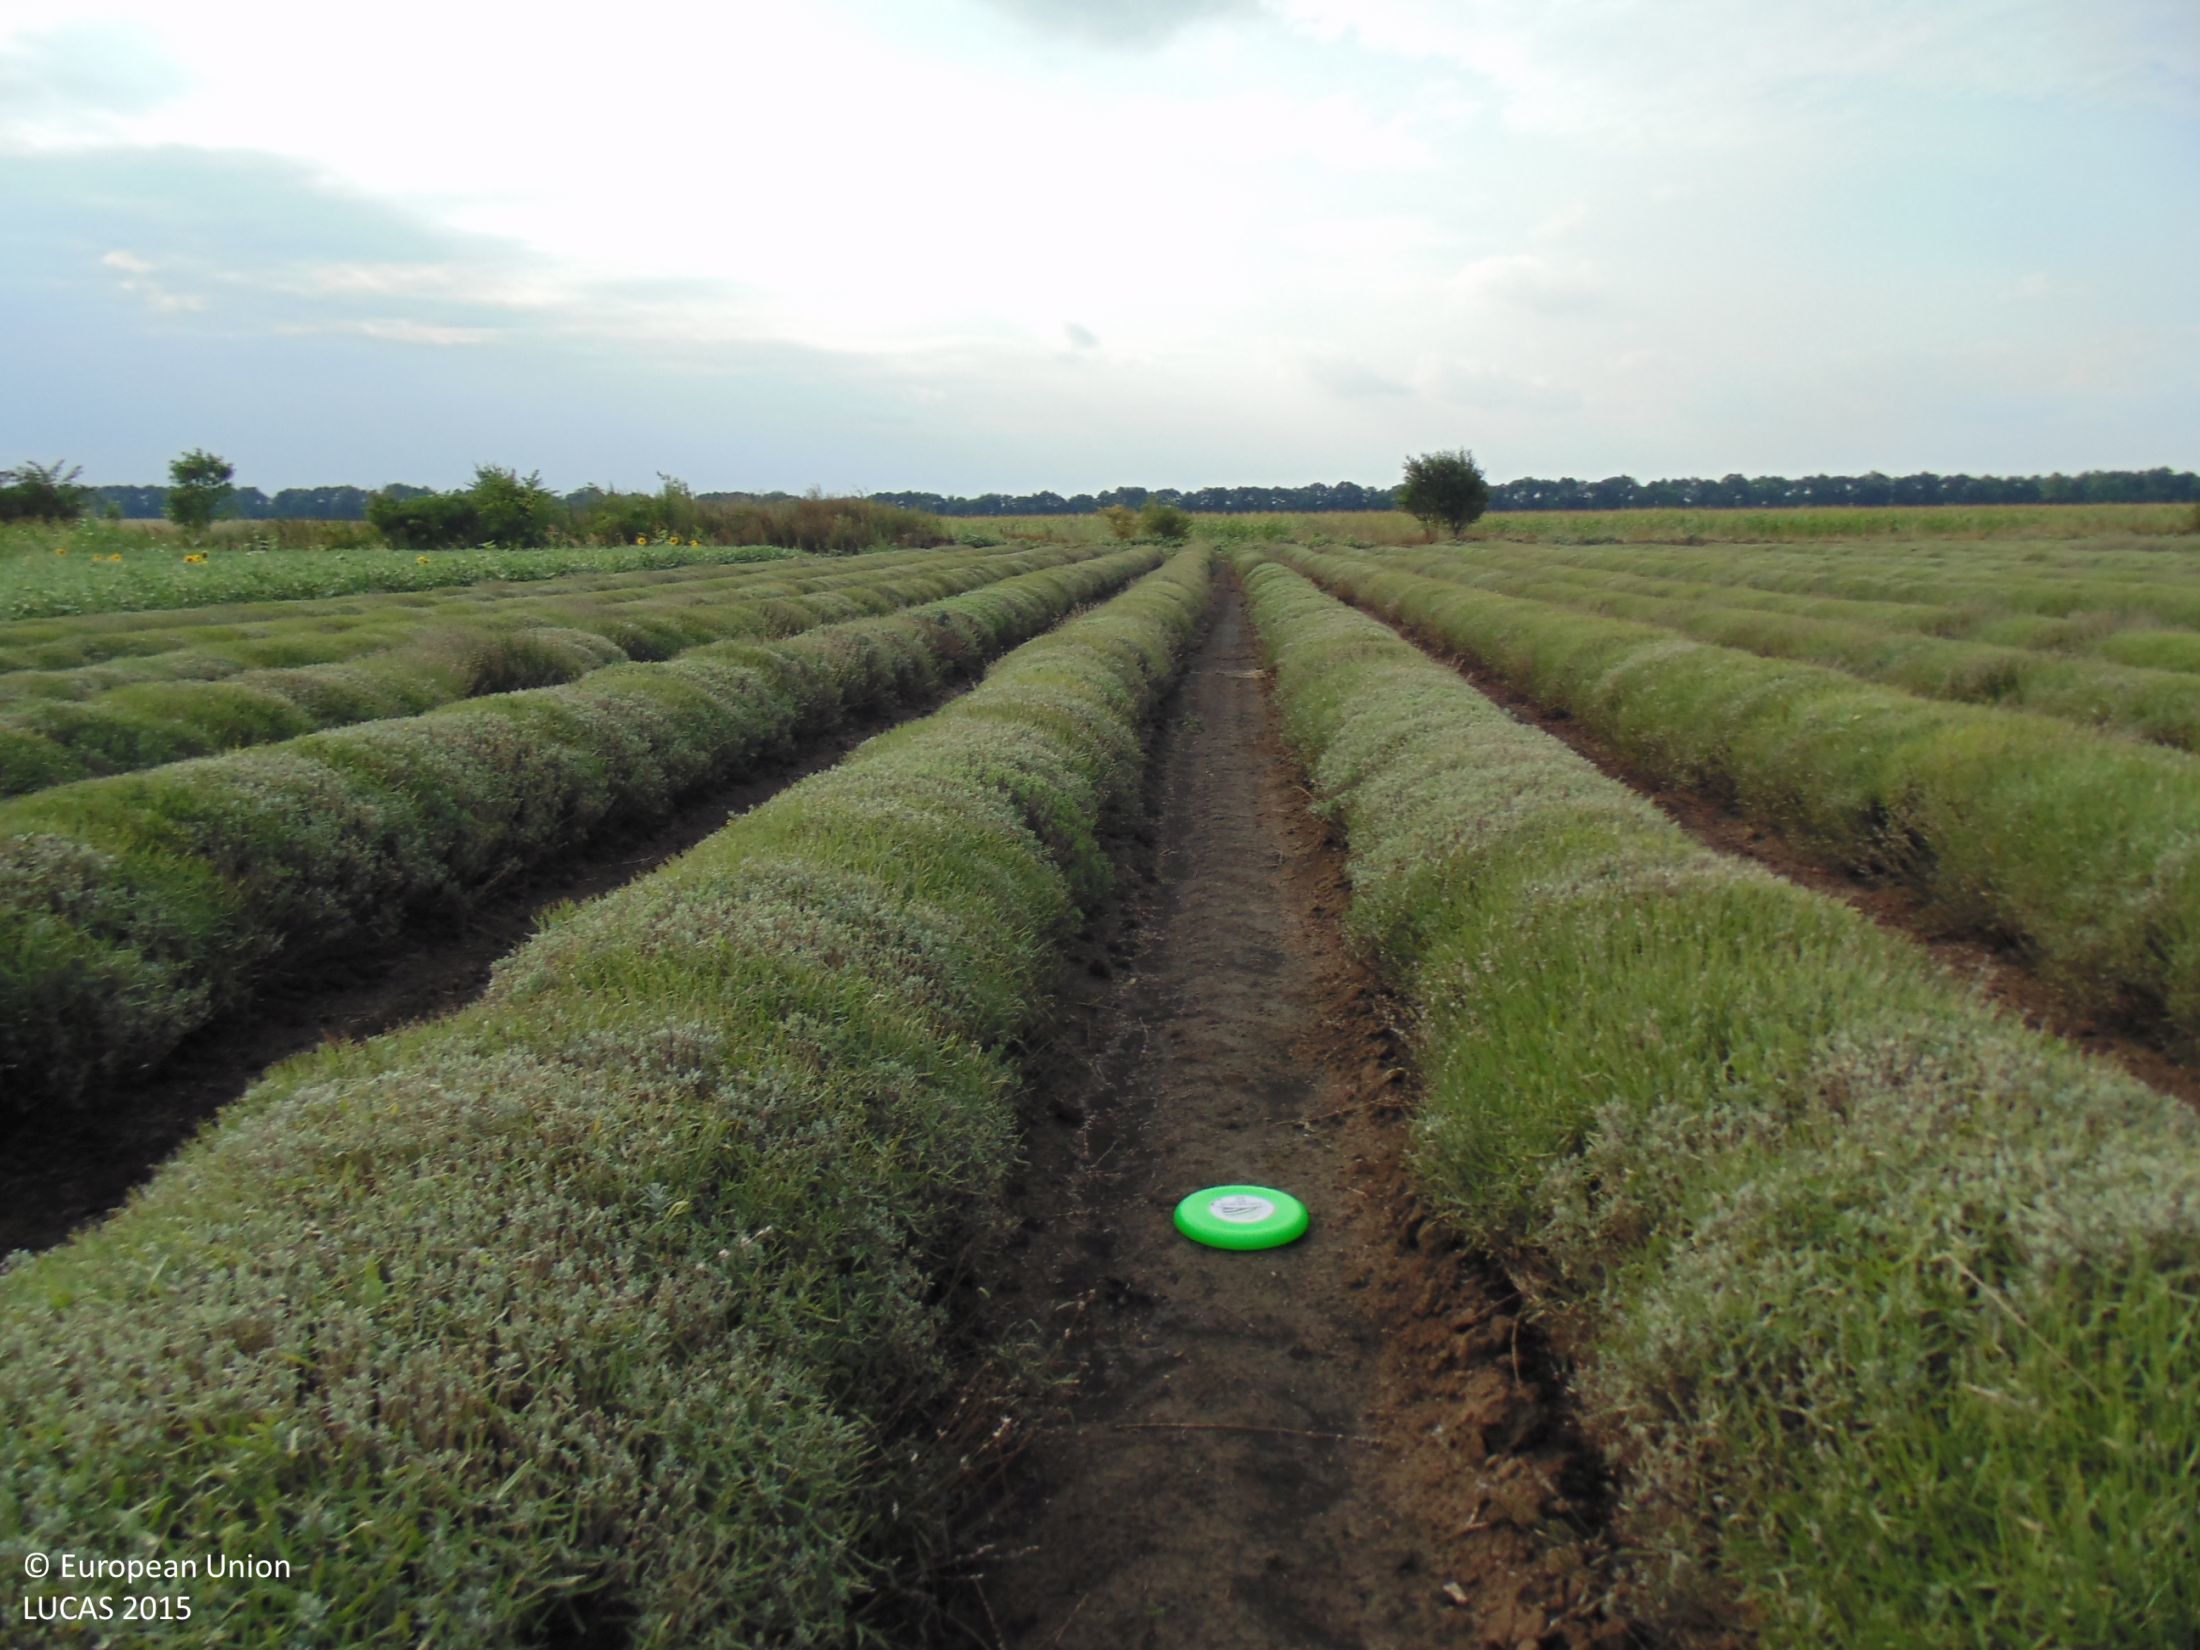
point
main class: Cropland
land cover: Other non-permanent industrial crops
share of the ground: > 75 %
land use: Agriculture (excluding fallow land and kitchen gardens)
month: August
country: BG
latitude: 43.7703
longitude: 28.0266
